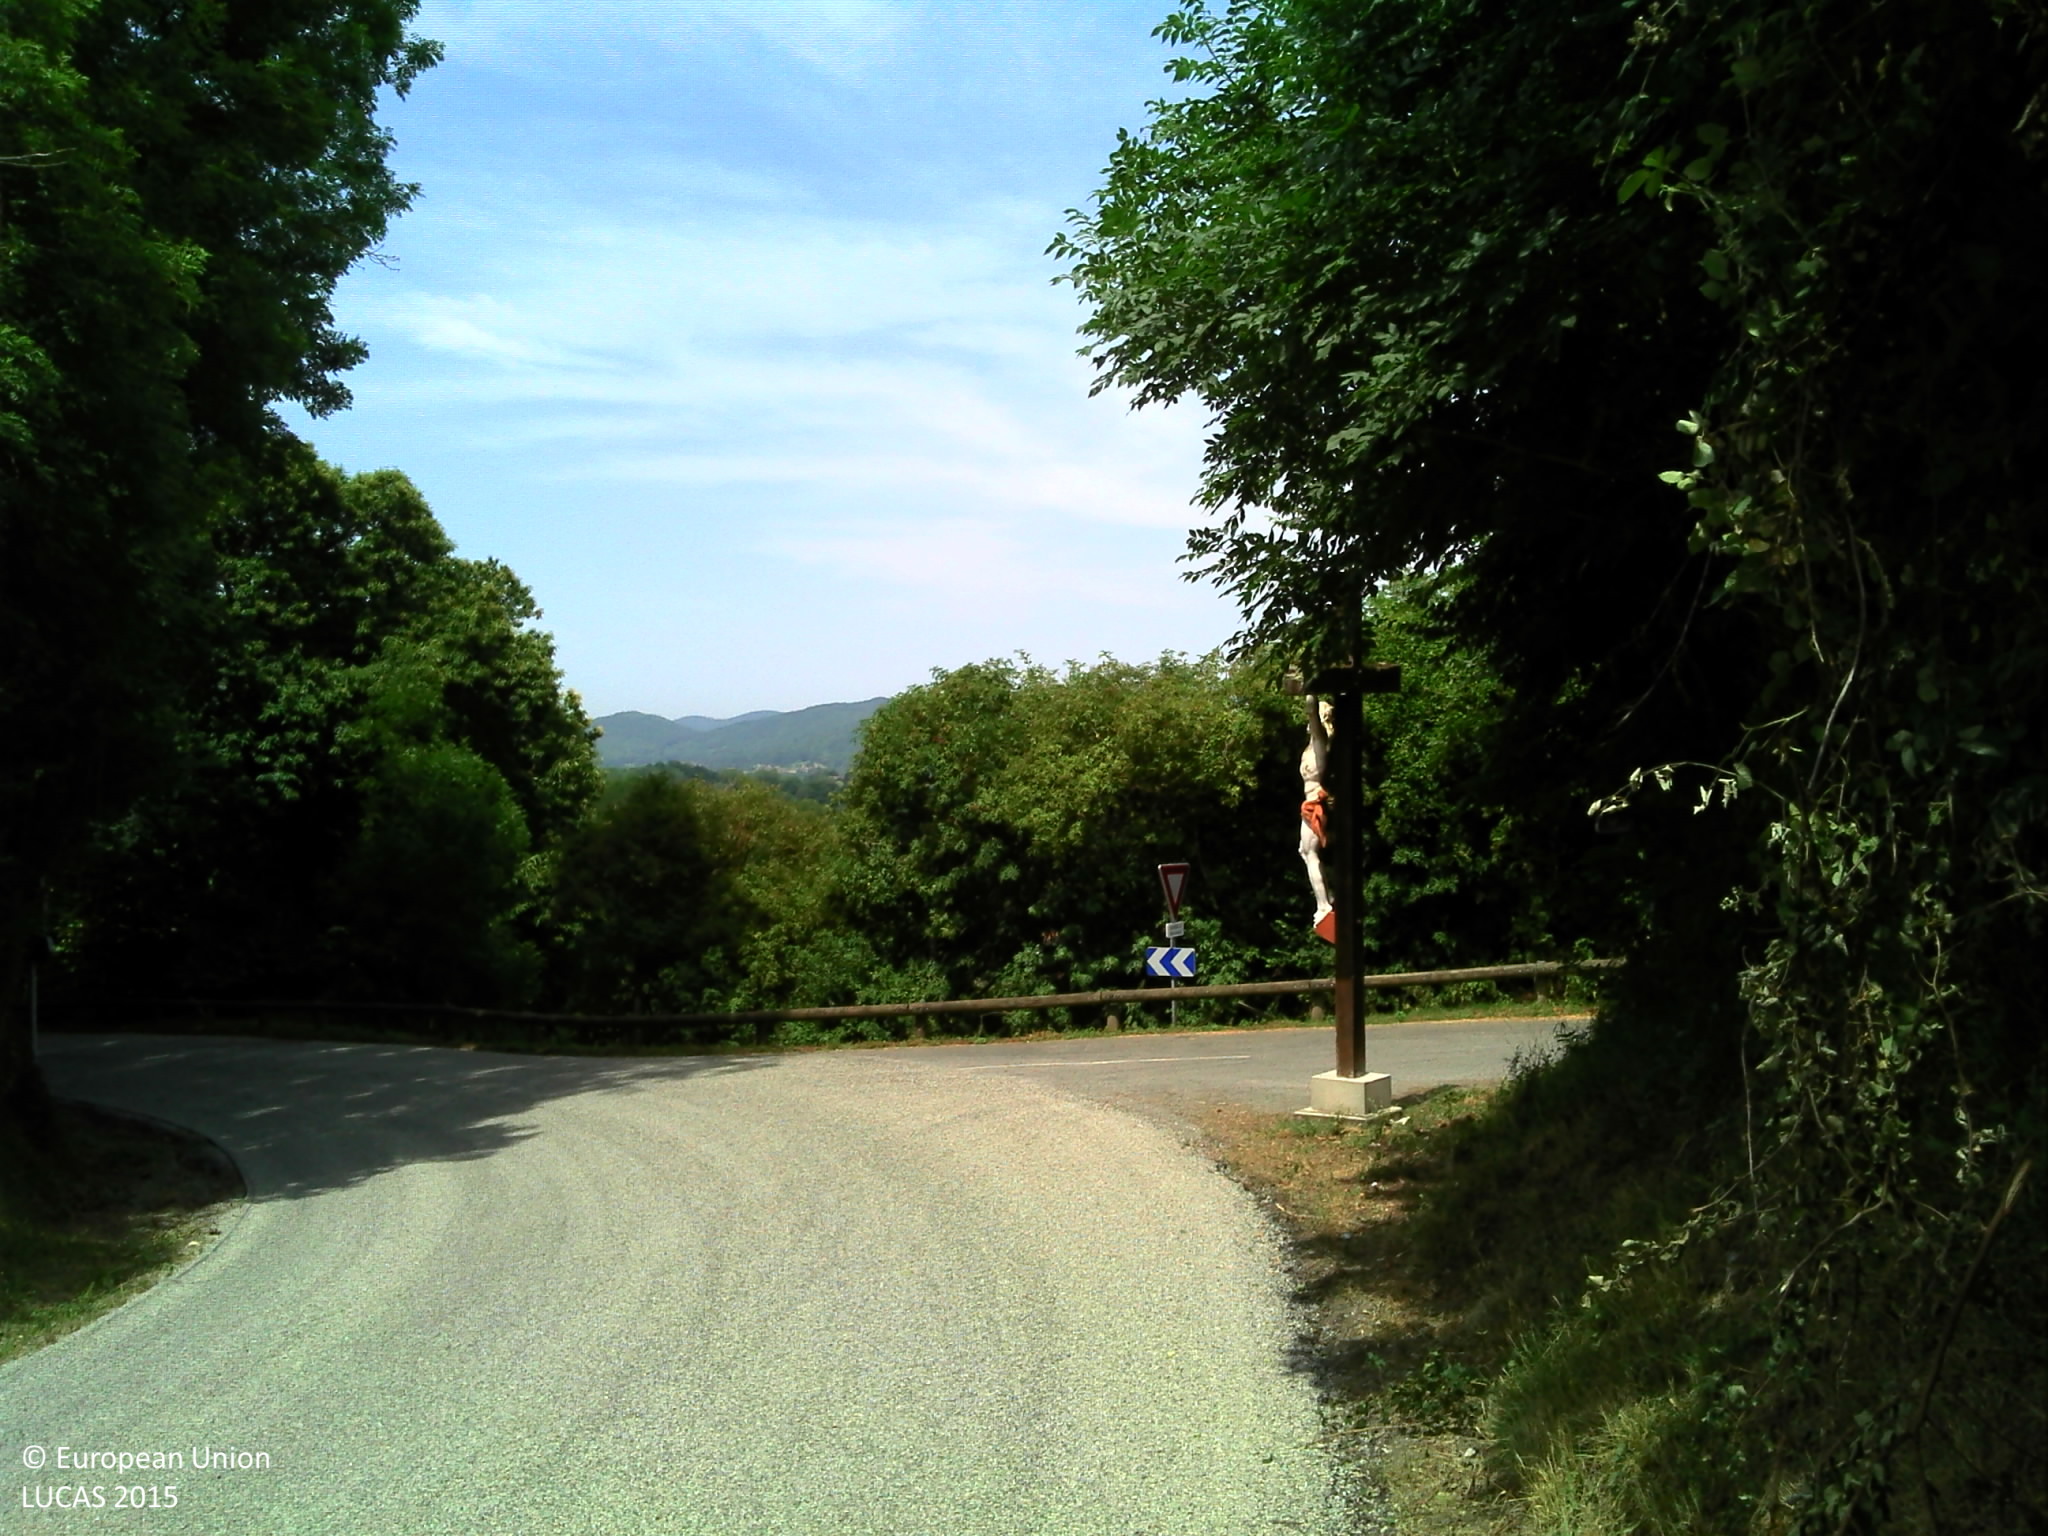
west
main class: Shrubland
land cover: Shrubland with sparse tree cover
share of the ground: > 75 %
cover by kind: shrubs 80 %, herbaceous plants 15 %, broadleaved forest trees 5 %
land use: Semi-natural and natural areas not in use
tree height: < 5 m
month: July
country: FR
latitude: 43.0502
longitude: 0.7827
